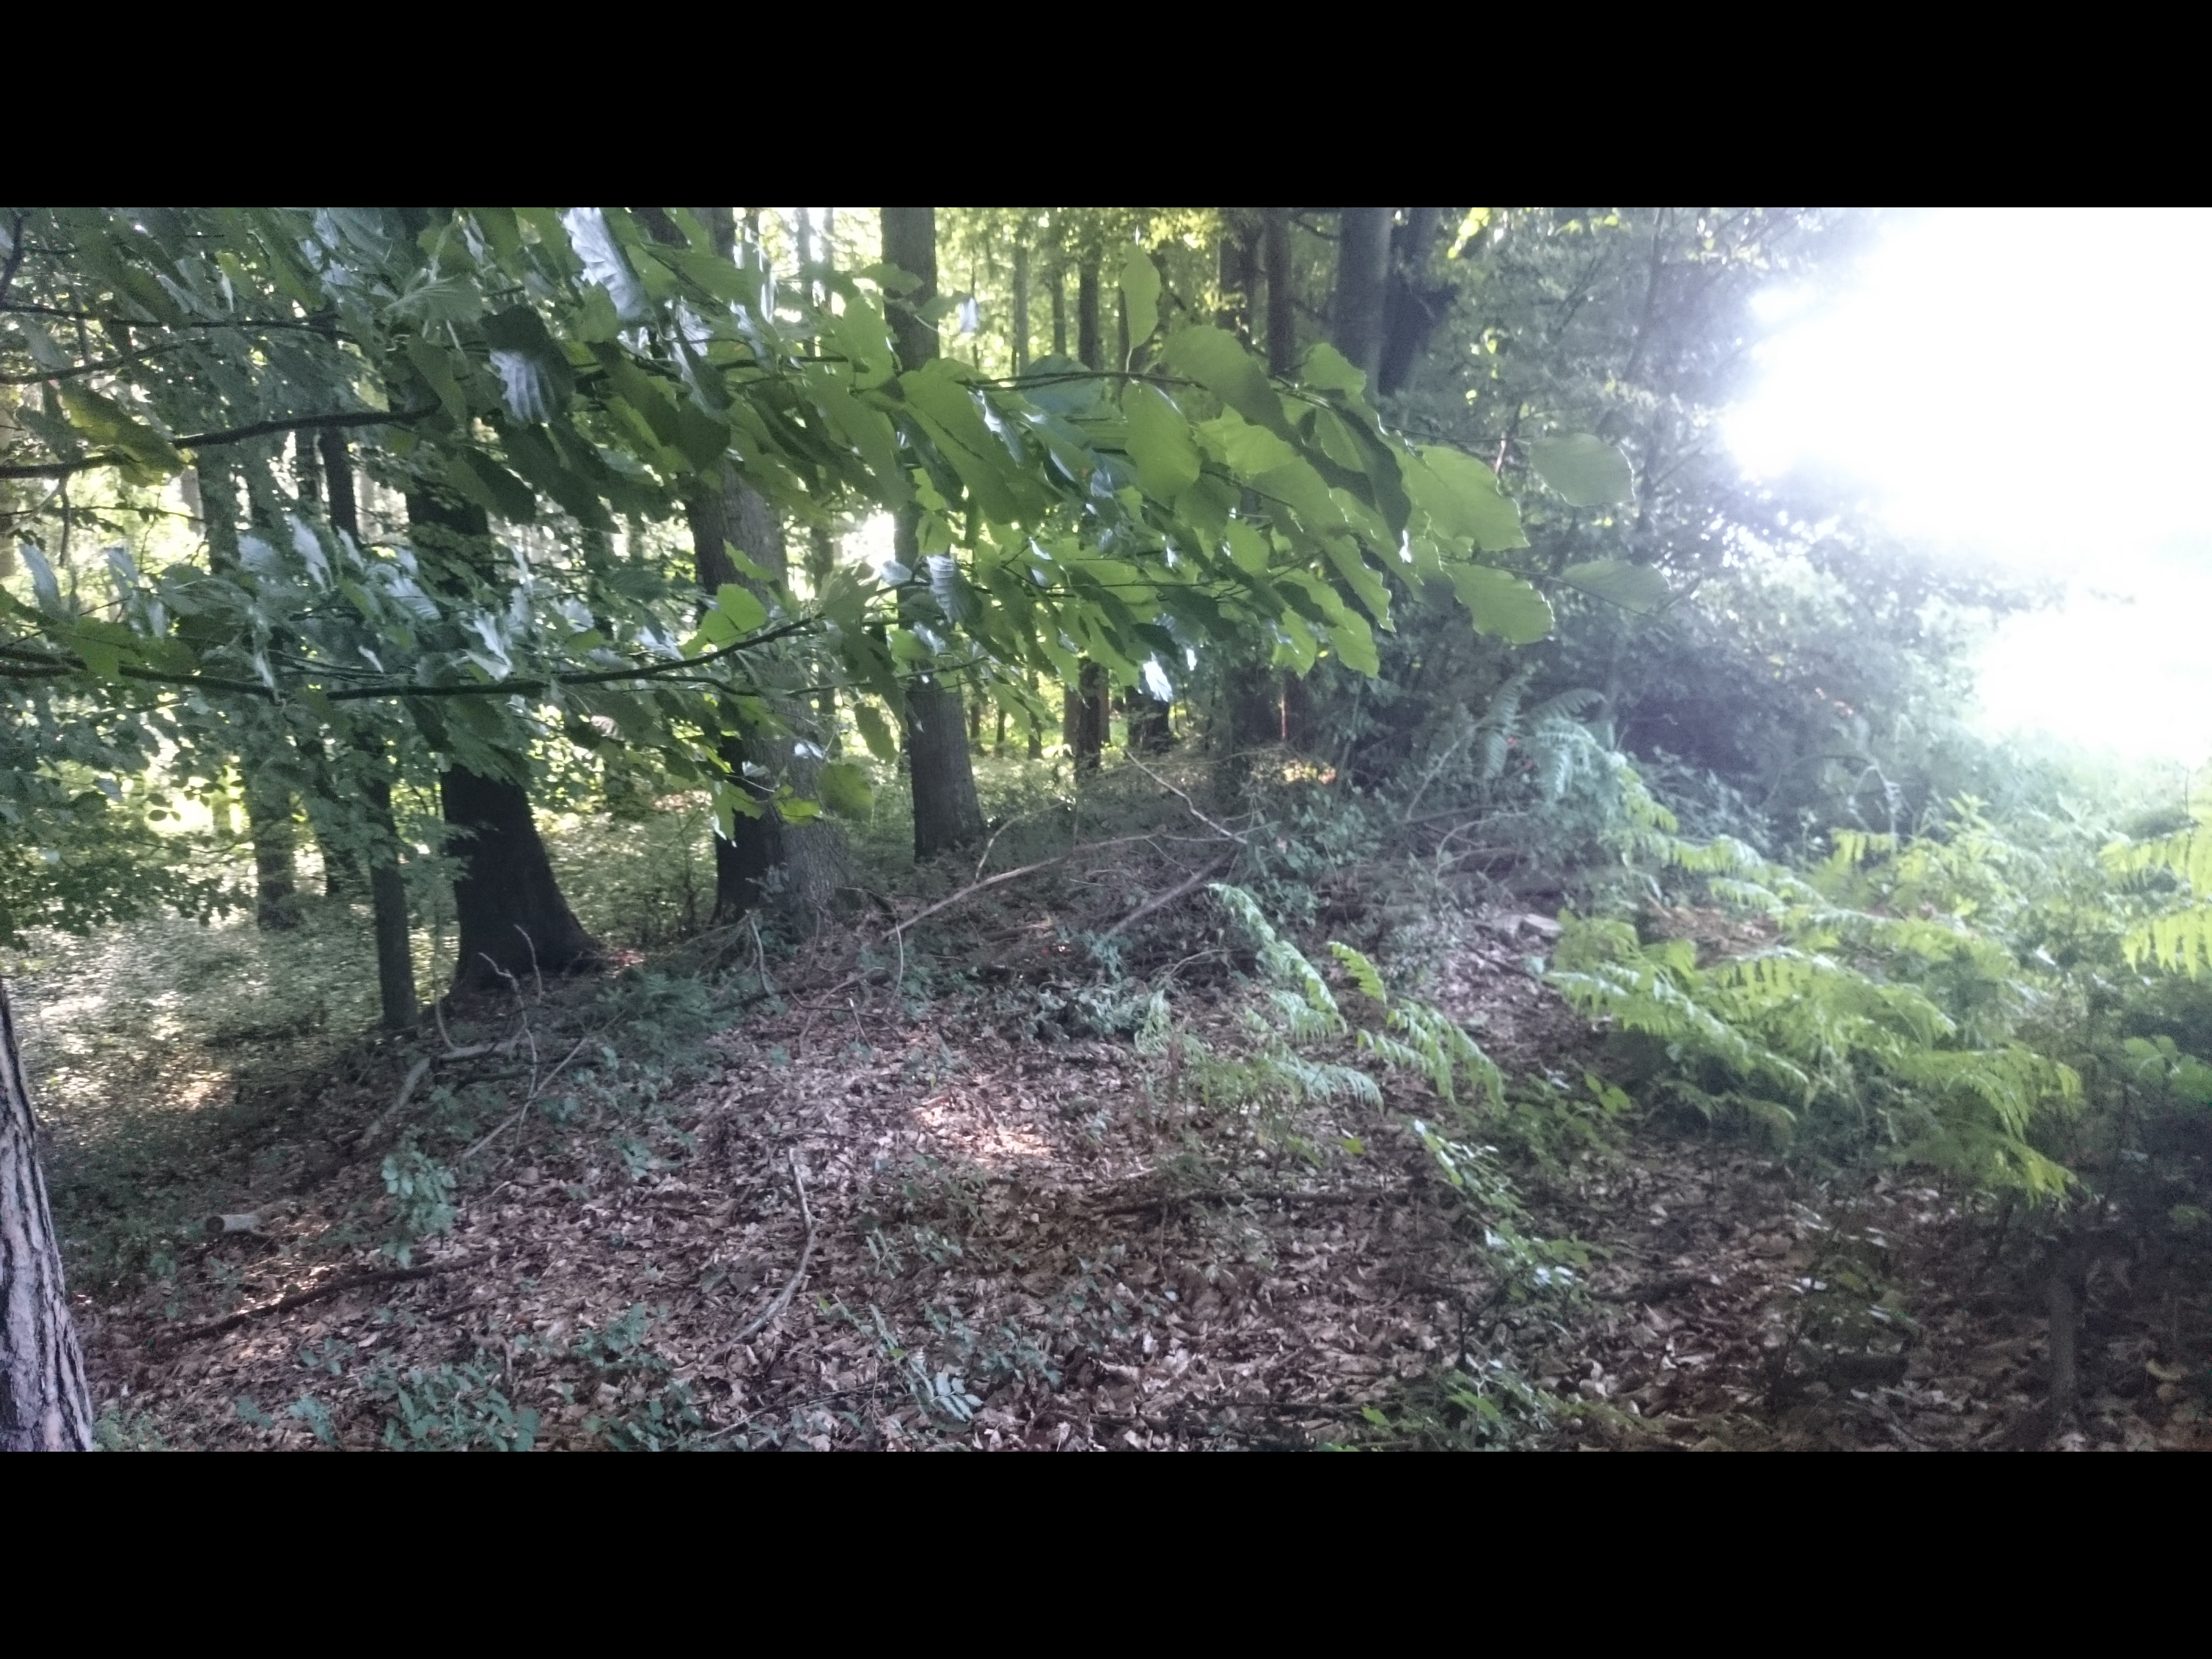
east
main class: Woodland
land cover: Broadleaved woodland
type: mountainous beech forest
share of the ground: > 75 %
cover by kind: broadleaved forest trees 80 %, coniferous forest trees 10 %, unconsolidated bare surface 10 %
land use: Forestry
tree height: > 5 m
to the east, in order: Broadleaved woodland; Tracks; Pine dominated mixed woodland
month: July
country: AT
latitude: 47.2119
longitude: 15.6649
